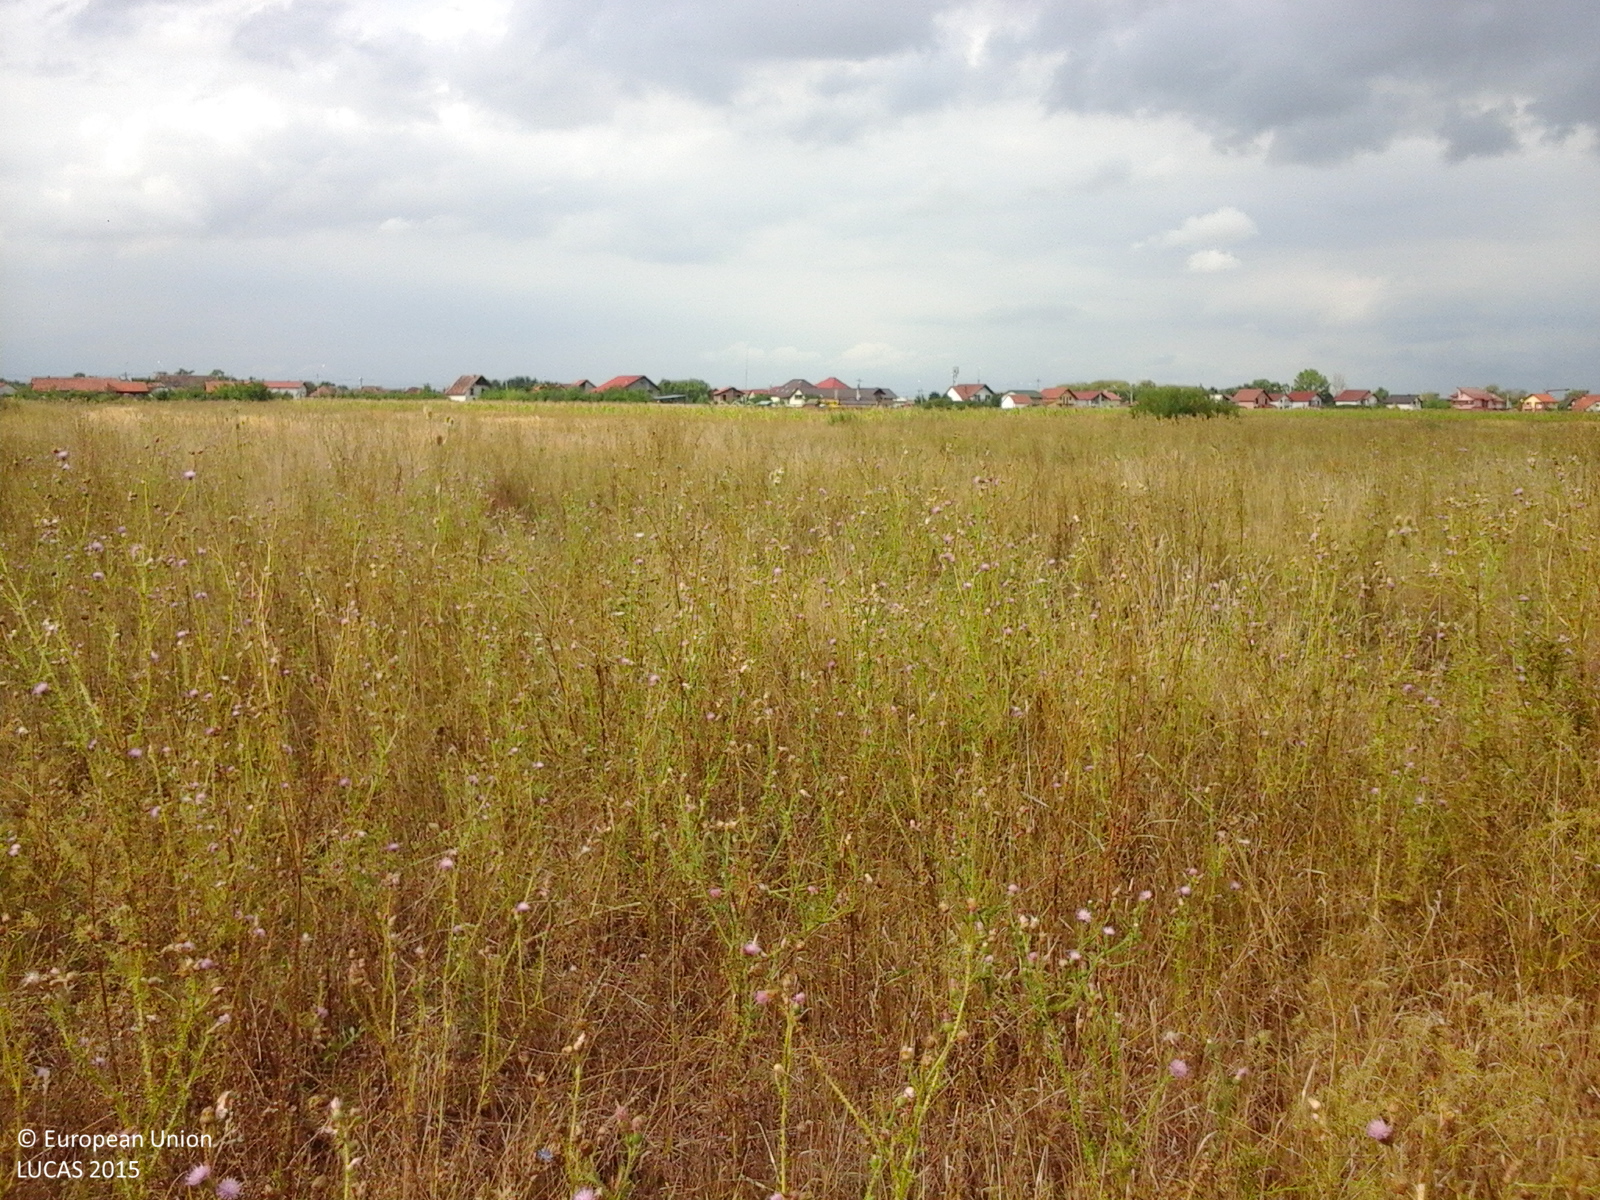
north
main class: Grassland
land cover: Spontaneously vegetated surfaces
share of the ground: > 75 %
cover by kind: herbaceous plants 100 %
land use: Fallow land
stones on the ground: < 10 %
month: August
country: RO
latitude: 45.7772
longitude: 21.3887
